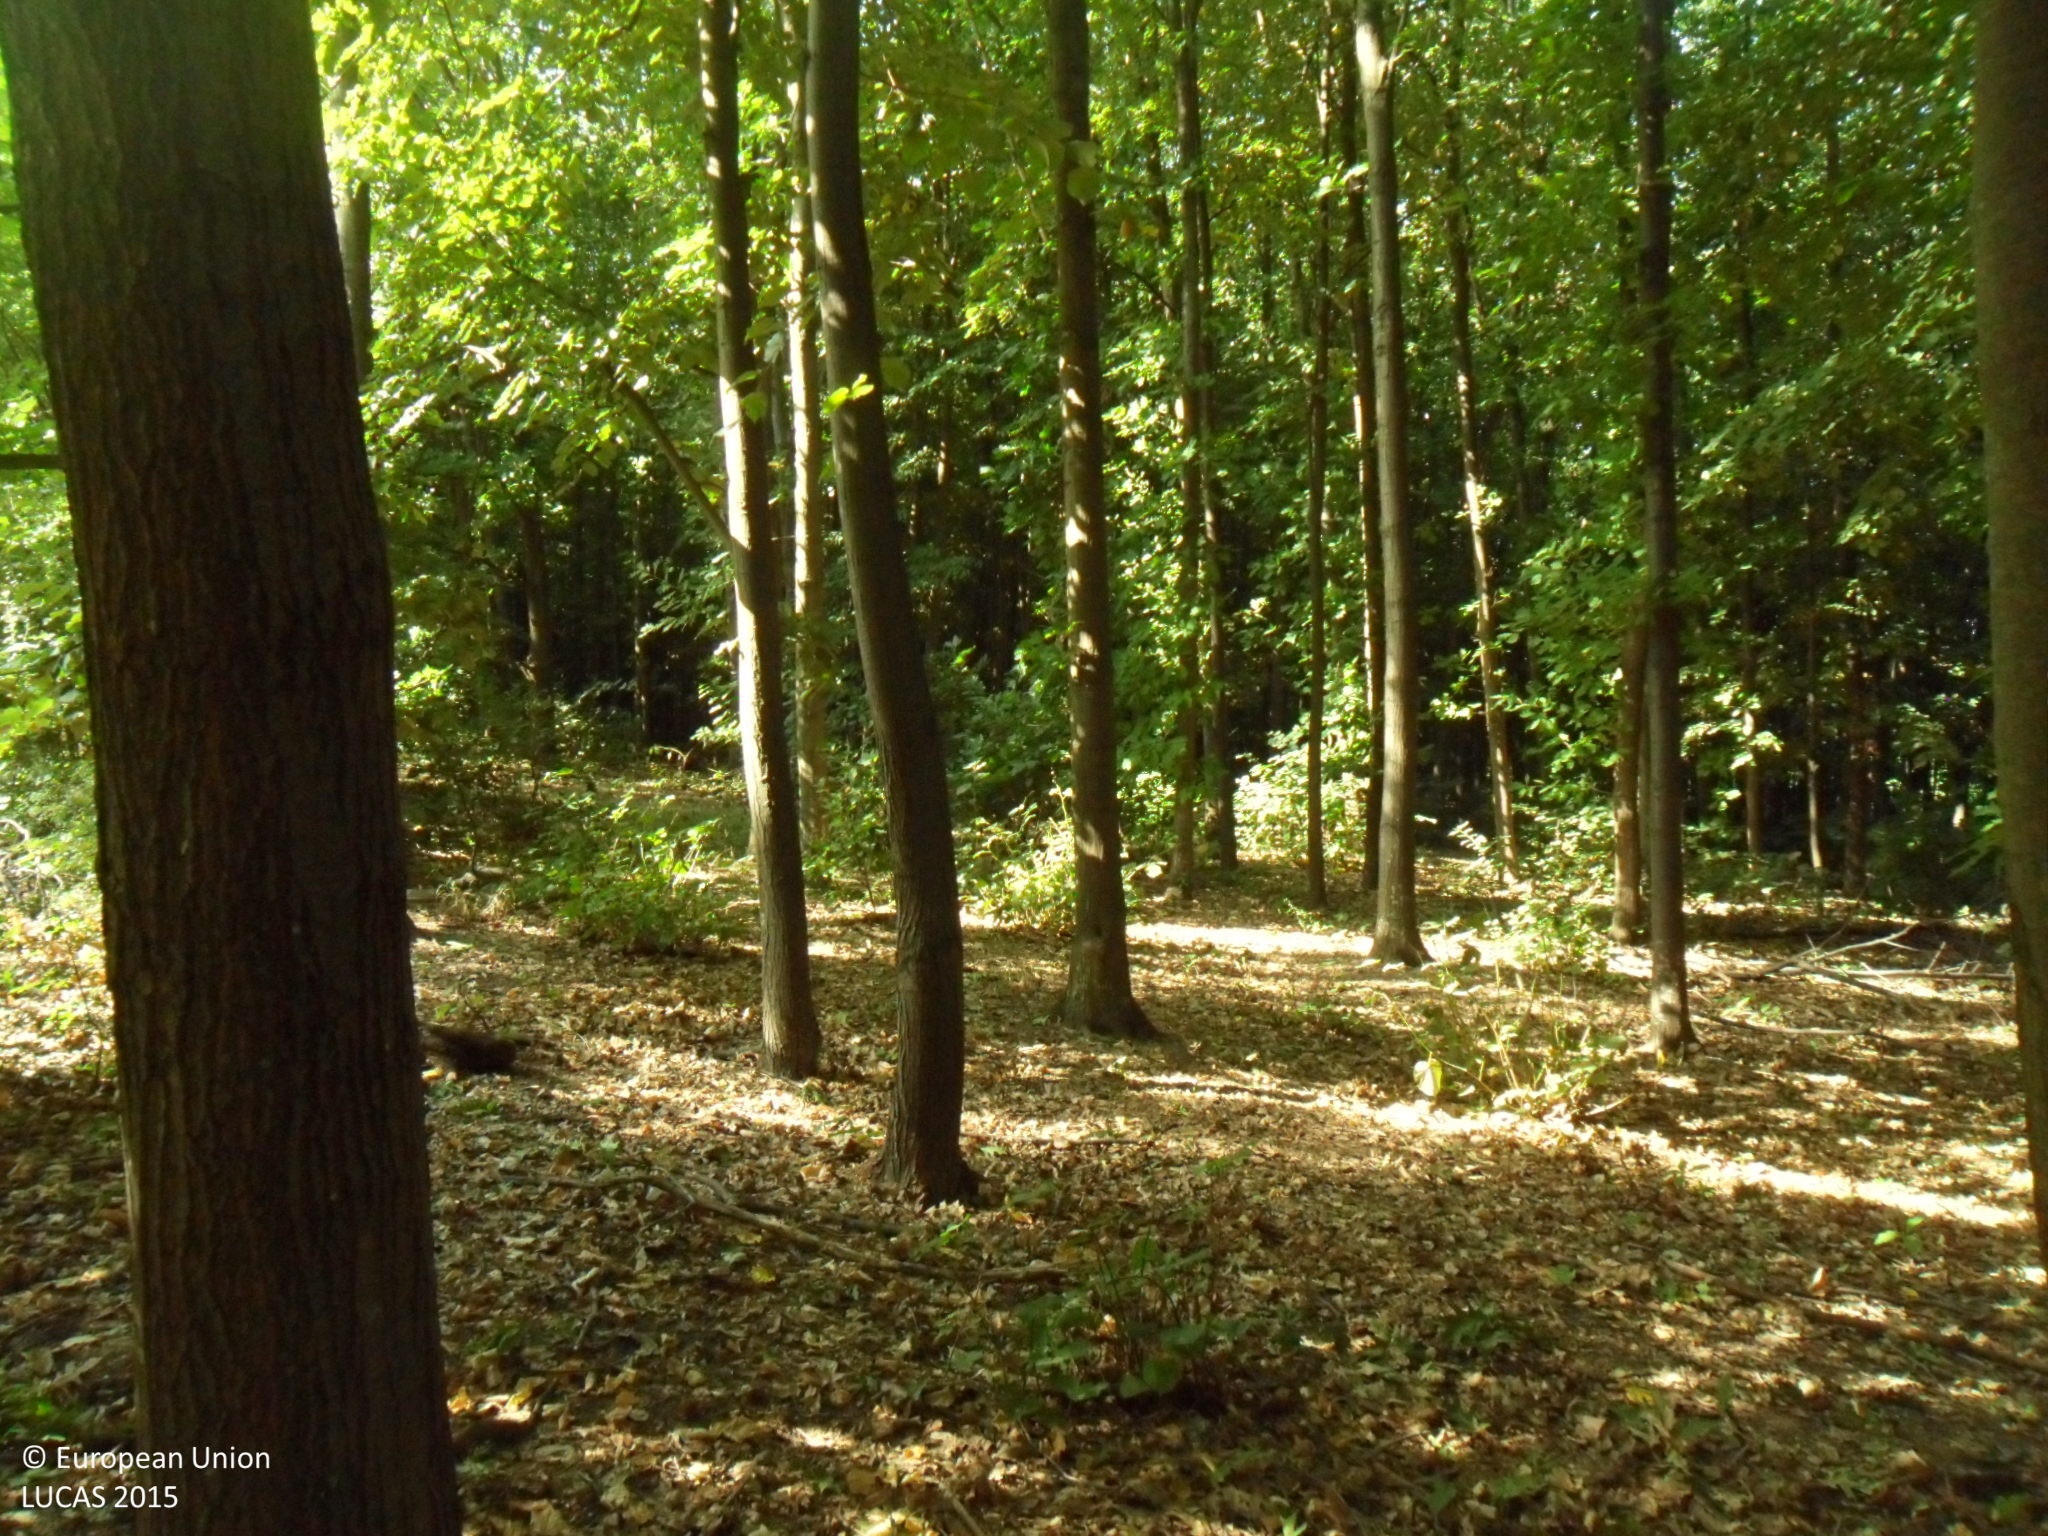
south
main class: Woodland
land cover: Broadleaved woodland
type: beech forest
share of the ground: > 75 %
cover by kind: broadleaved forest trees 95 %, unconsolidated bare surface 5 %
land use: Forestry
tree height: > 5 m
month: September
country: BG
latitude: 43.9117
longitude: 26.4328
